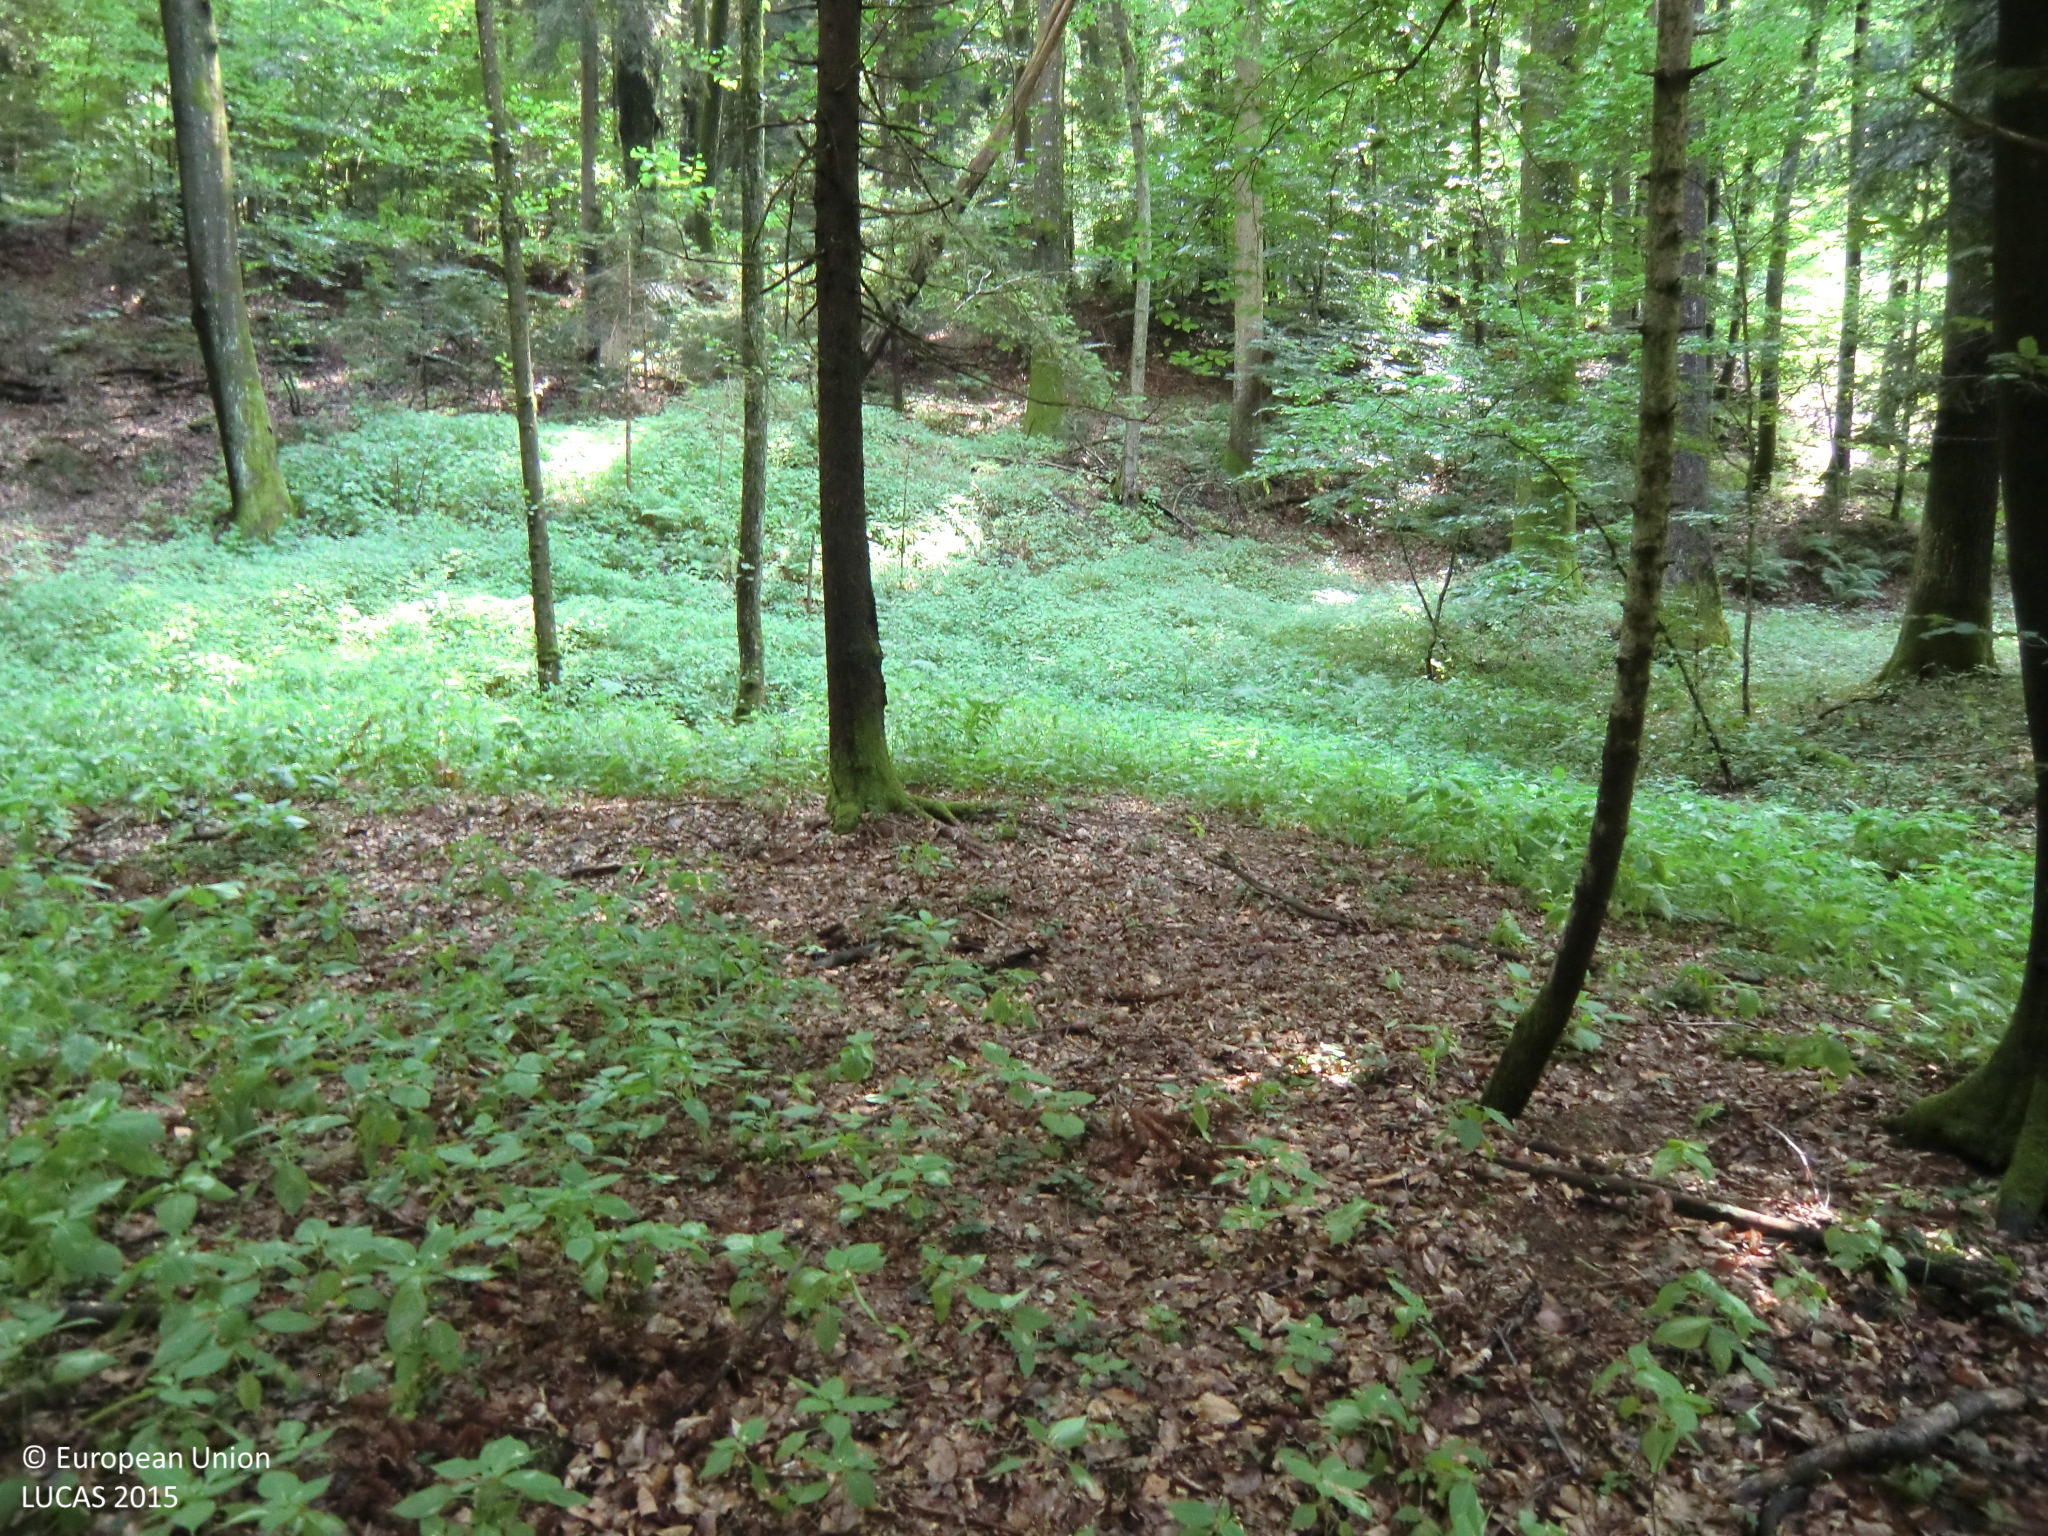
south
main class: Woodland
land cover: Spruce dominated mixed woodland
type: hemiboreal forest and nemoral coniferous forest and mixed broadleaved-coniferous forest
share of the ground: > 75 %
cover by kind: coniferous forest trees 45 %, broadleaved forest trees 40 %, herbaceous plants 15 %
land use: Forestry
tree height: > 5 m
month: July
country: AT
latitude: 47.0642
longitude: 15.7281
